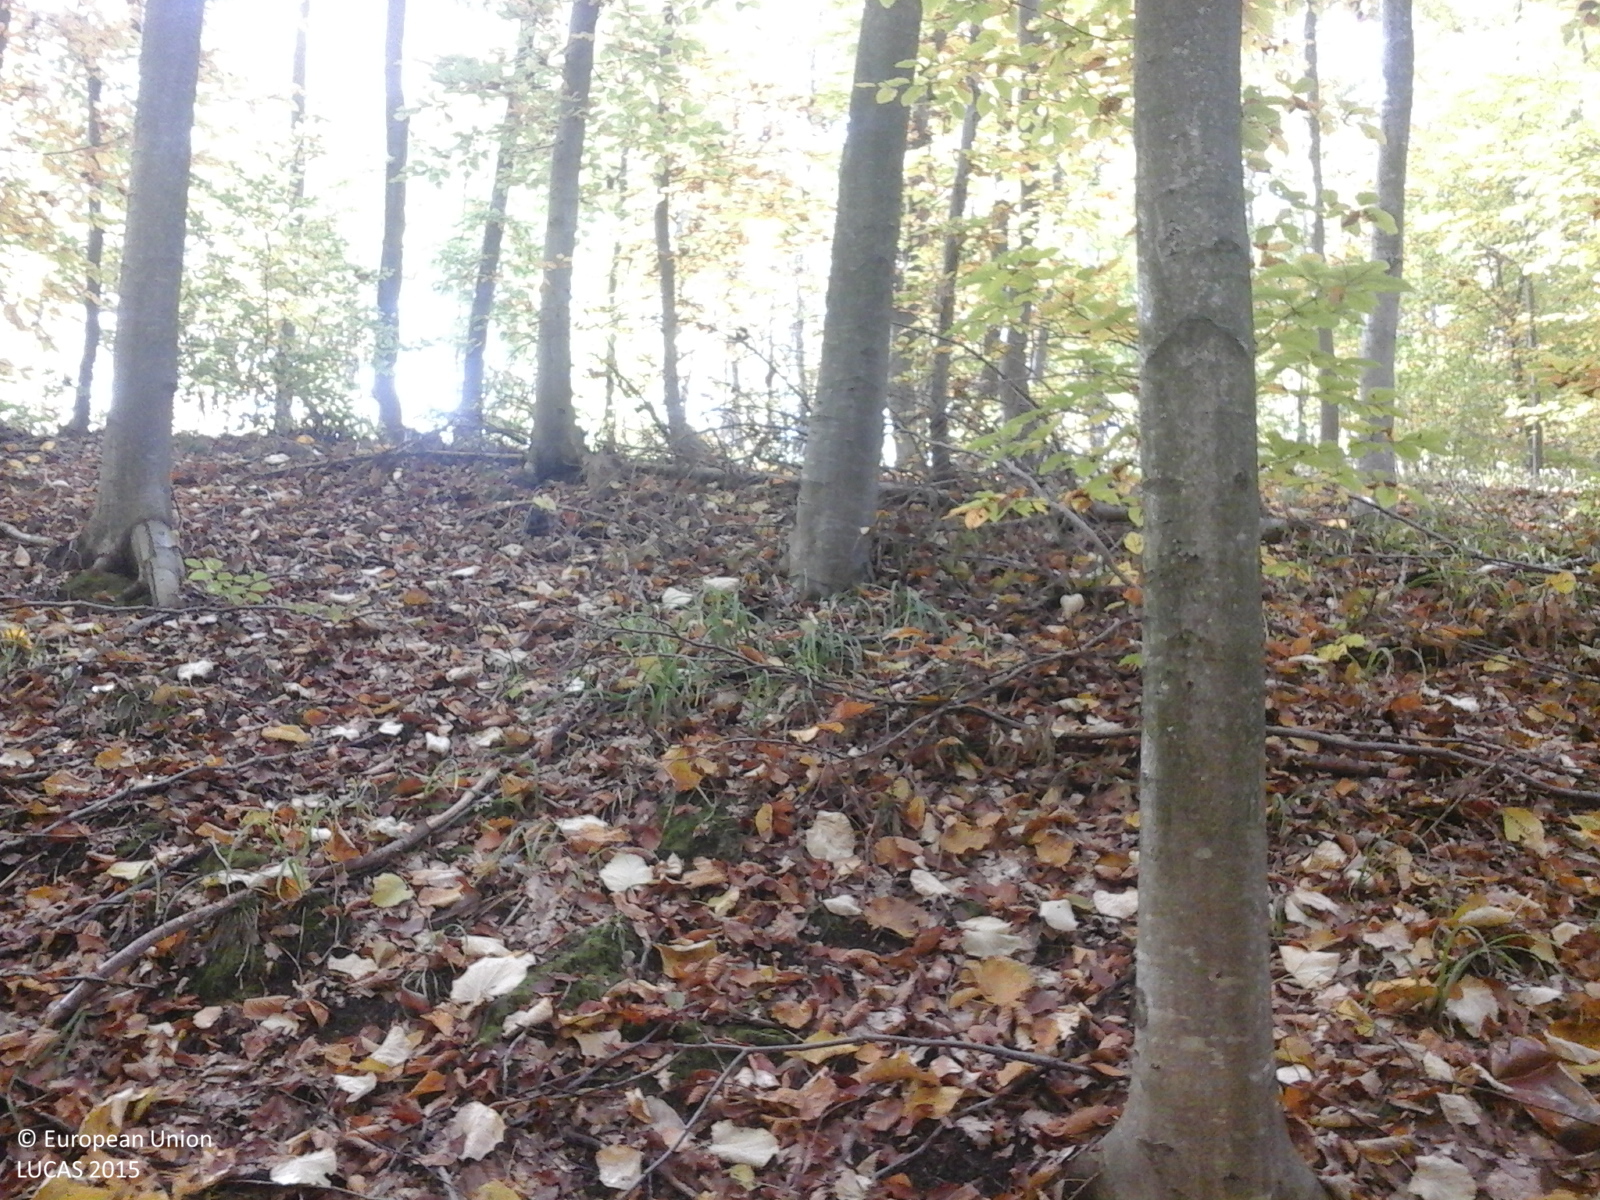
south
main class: Woodland
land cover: Broadleaved woodland
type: beech forest
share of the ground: > 75 %
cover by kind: broadleaved forest trees 100 %
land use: Forestry
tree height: > 5 m
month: October
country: RO
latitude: 45.1420
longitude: 26.4368
